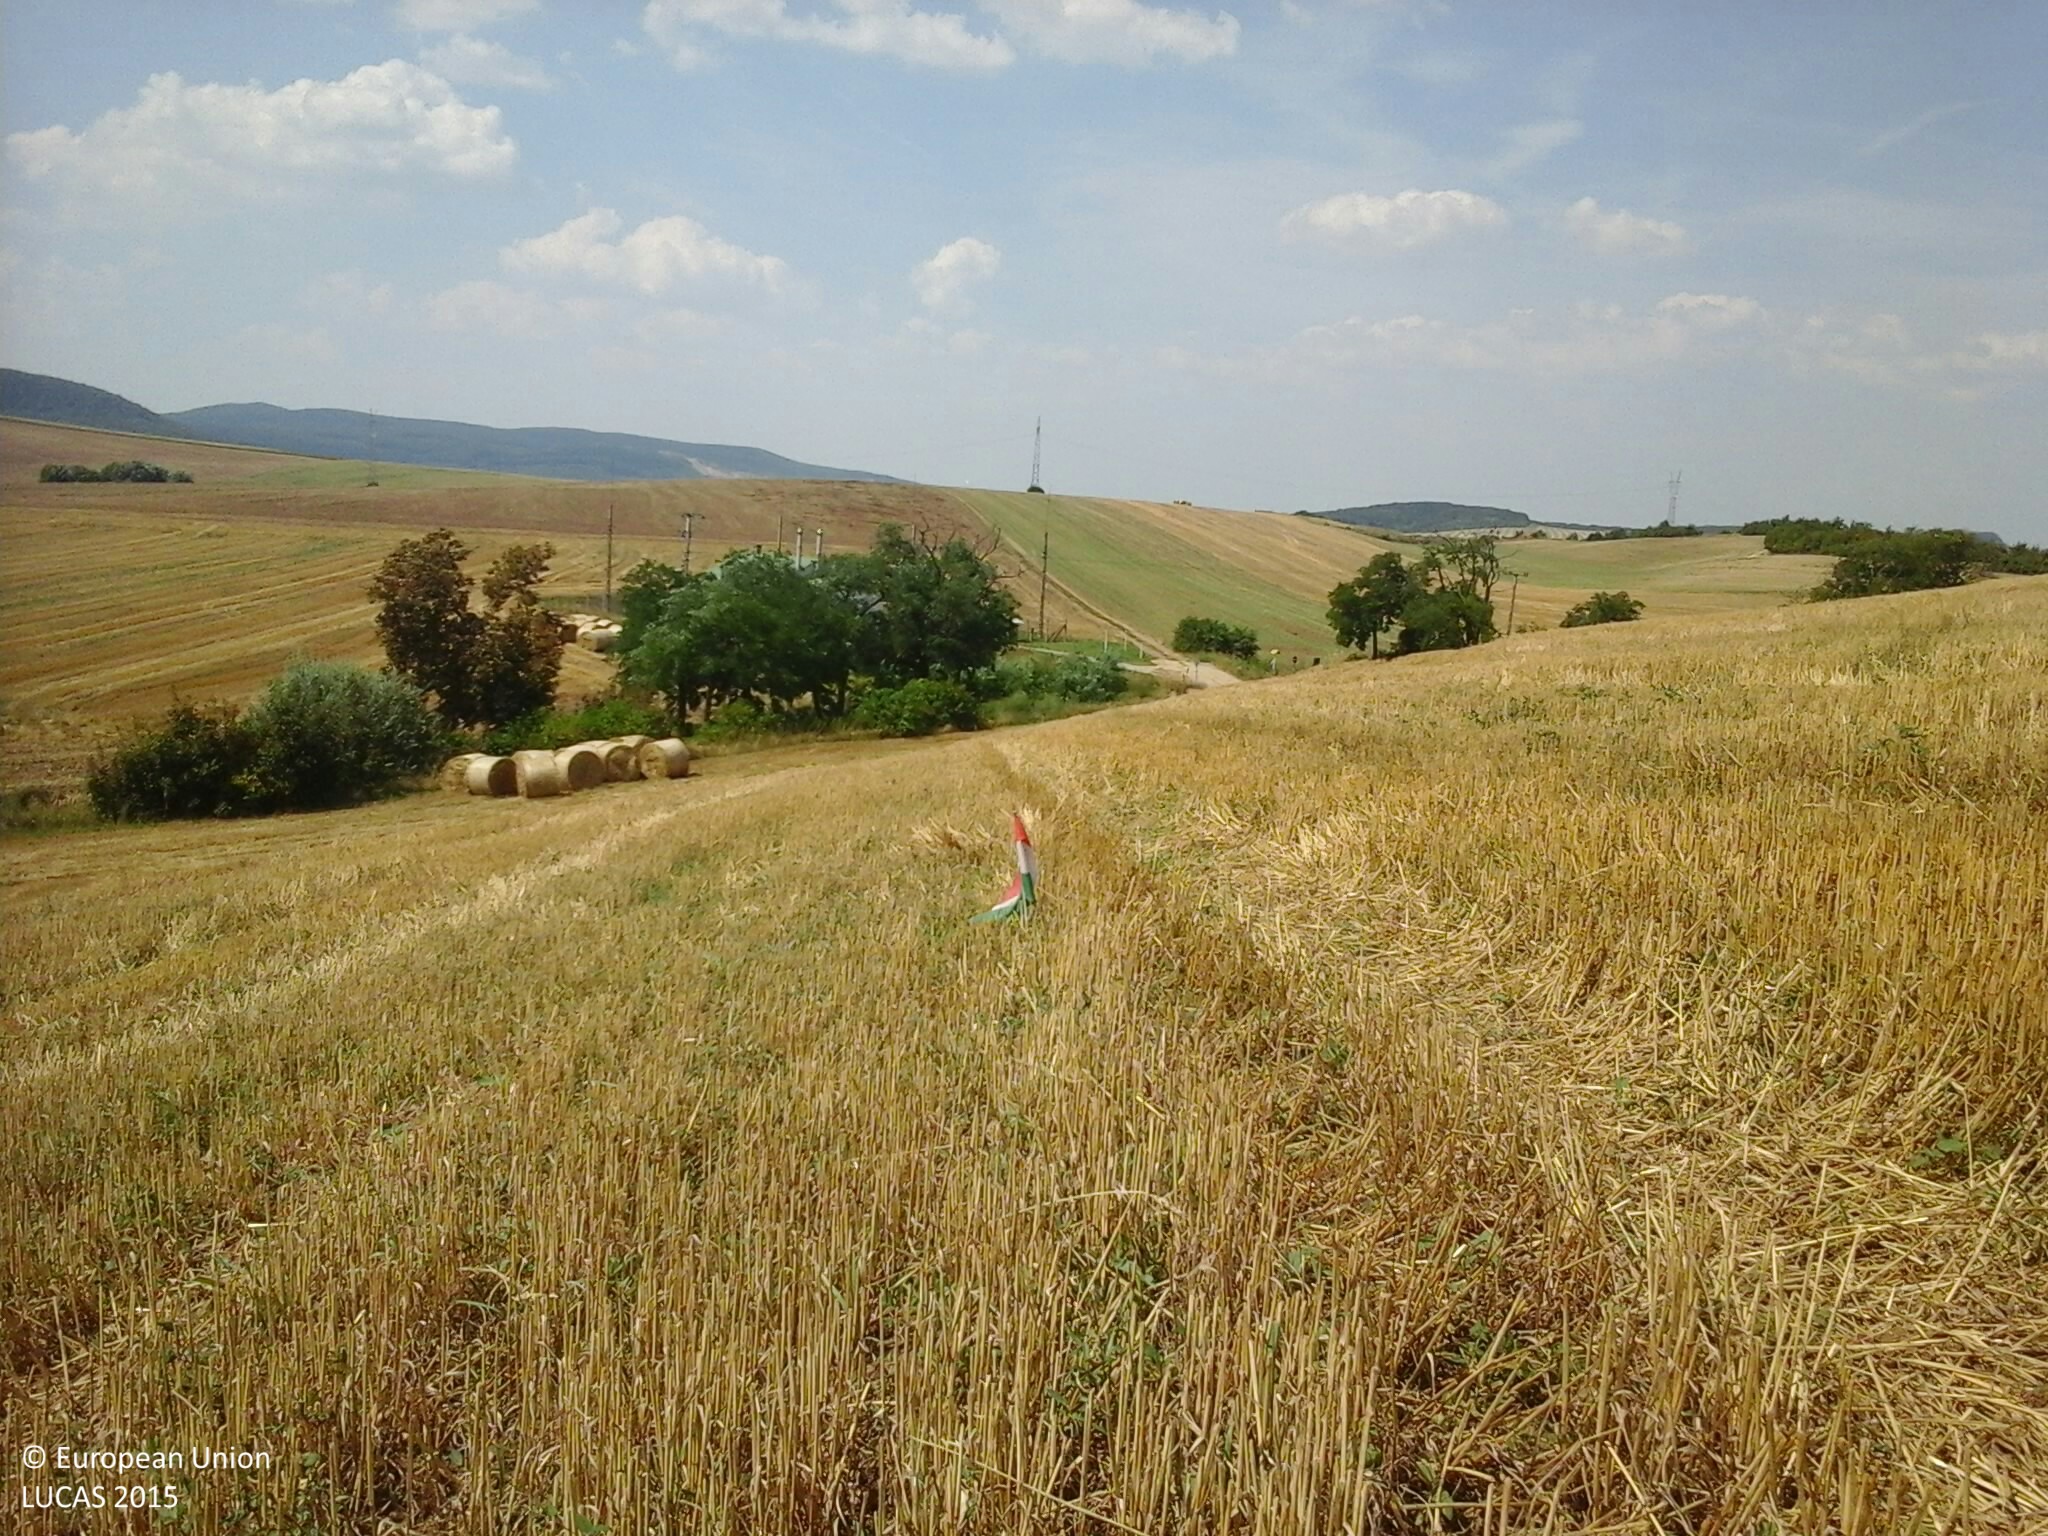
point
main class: Cropland
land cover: Common wheat
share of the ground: > 75 %
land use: Agriculture (excluding fallow land and kitchen gardens)
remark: Harvested field
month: August
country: HU
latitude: 47.6694
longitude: 18.6053
